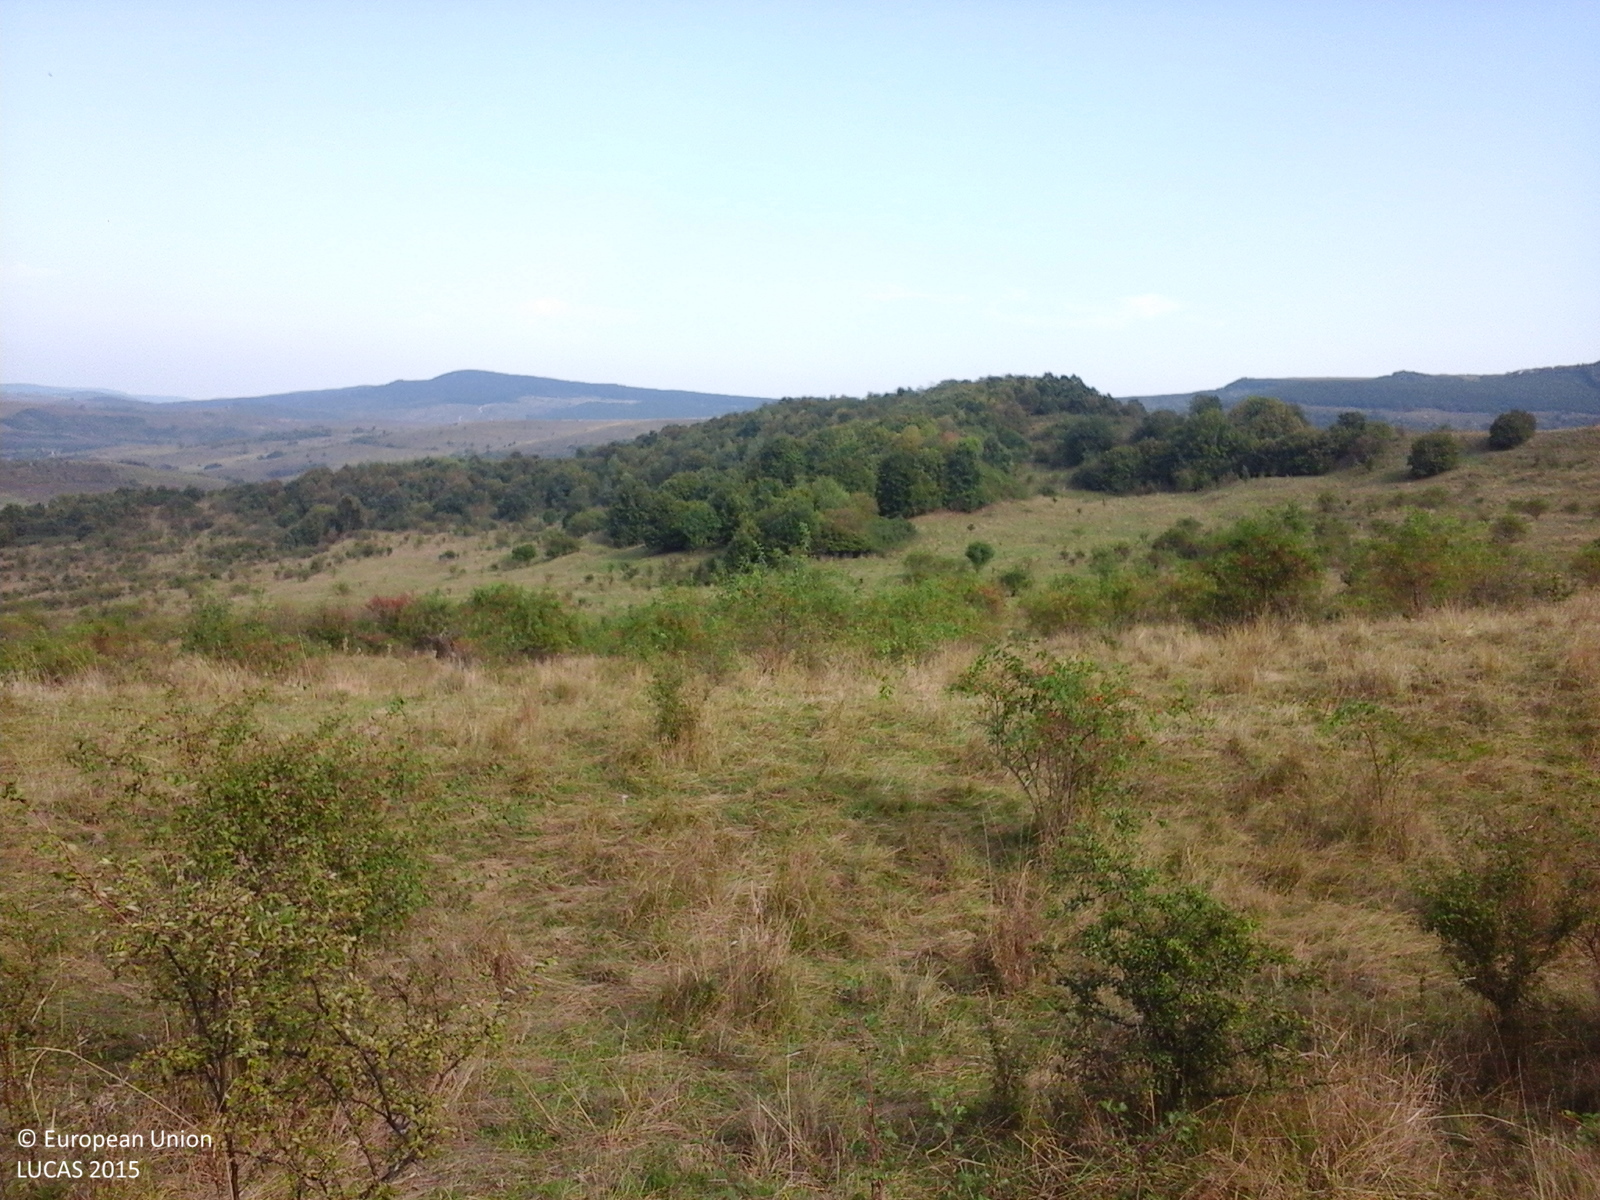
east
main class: Grassland
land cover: Grassland with sparse tree/shrub cover
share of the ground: > 75 %
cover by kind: herbaceous plants 85 %, shrubs 10 %, broadleaved forest trees 5 %
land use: Agriculture (excluding fallow land and kitchen gardens)
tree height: < 5 m
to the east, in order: Grassland with sparse tree/shrub cover; Shrubland with sparse tree cover
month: September
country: RO
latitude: 47.1125
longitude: 23.6618
